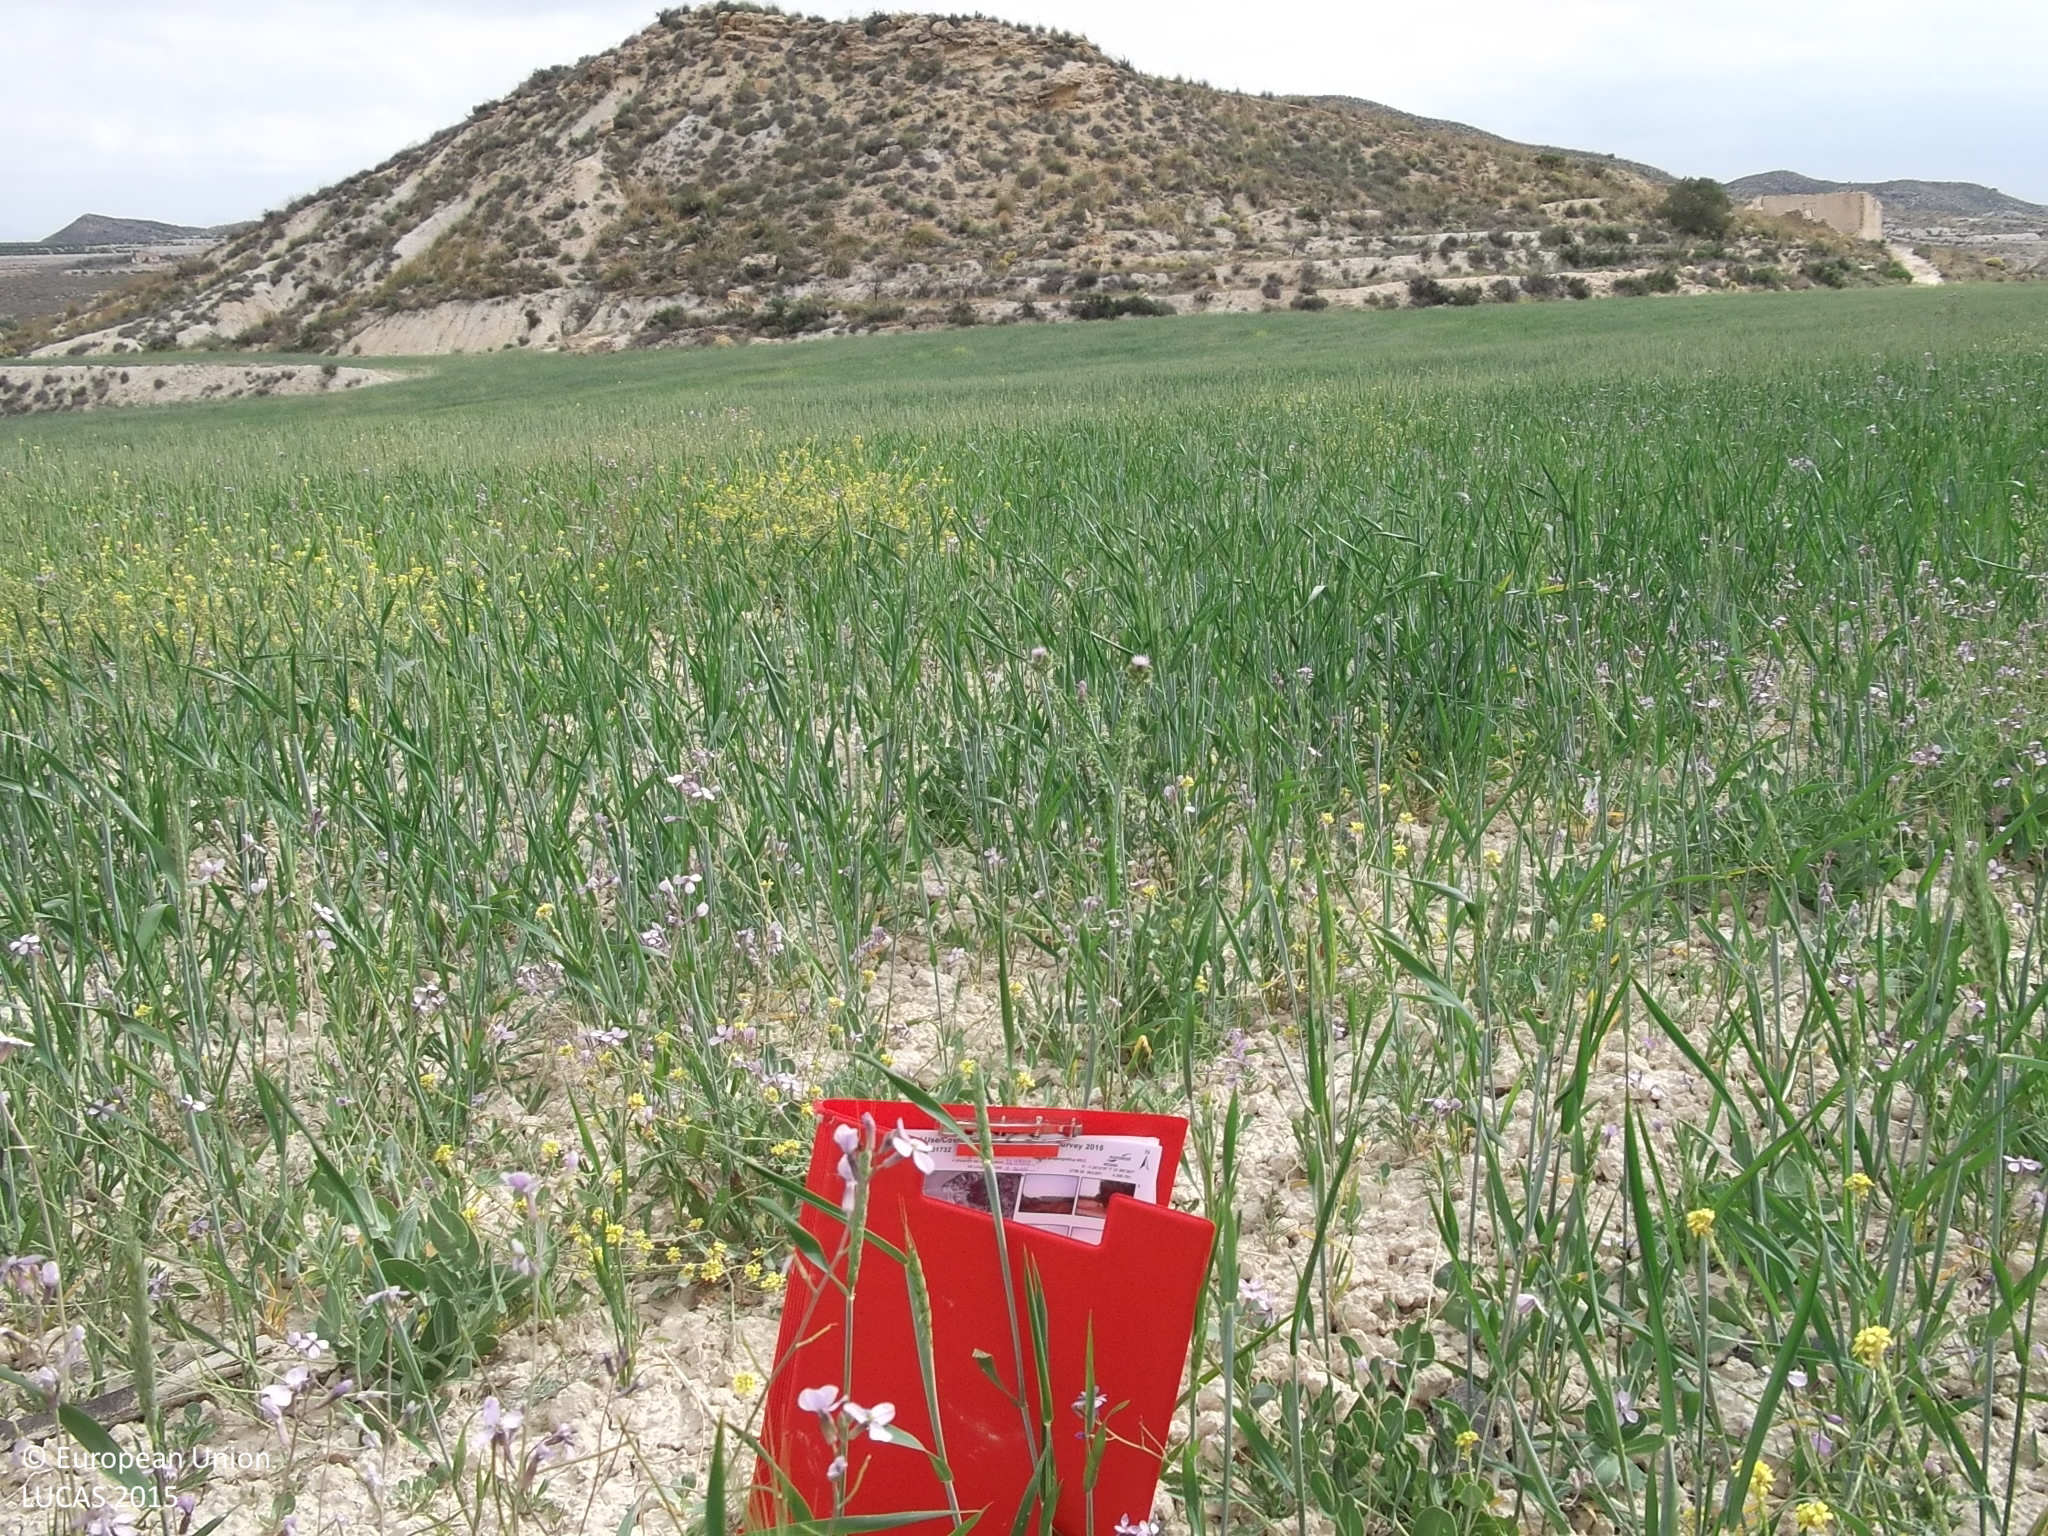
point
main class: Cropland
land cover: Common wheat
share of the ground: > 75 %
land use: Agriculture (excluding fallow land and kitchen gardens)
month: April
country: ES
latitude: 37.9973
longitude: -1.3612
